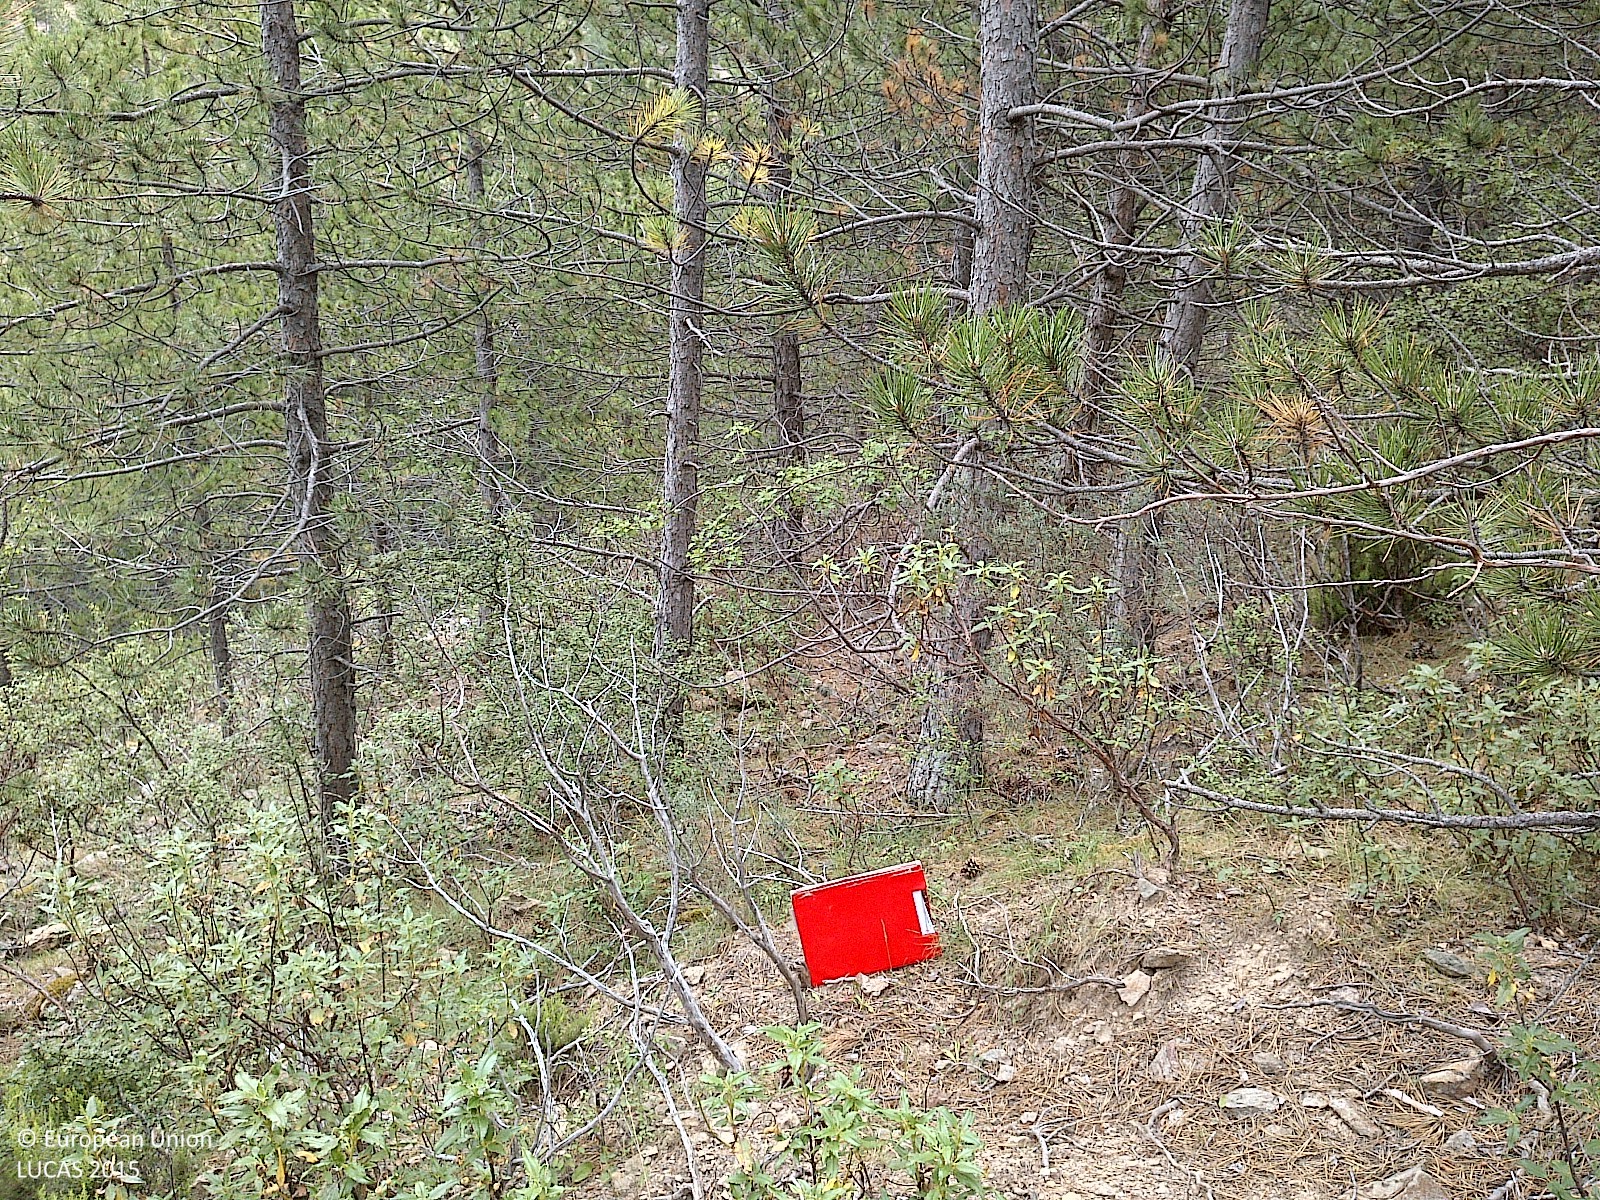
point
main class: Woodland
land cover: Pine dominated coniferous woodland
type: coniferous forest of the mediterranean region
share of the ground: 50 - 75 %
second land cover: Grassland without tree/shrub cover
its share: 25 - 50 %
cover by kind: coniferous forest trees 65 %, shrubs 15 %, herbaceous plants 15 %, consolidated bare surface 5 %
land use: Forestry
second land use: Agriculture (excluding fallow land and kitchen gardens)
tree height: > 5 m
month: July
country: ES
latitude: 42.0736
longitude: -2.2340
